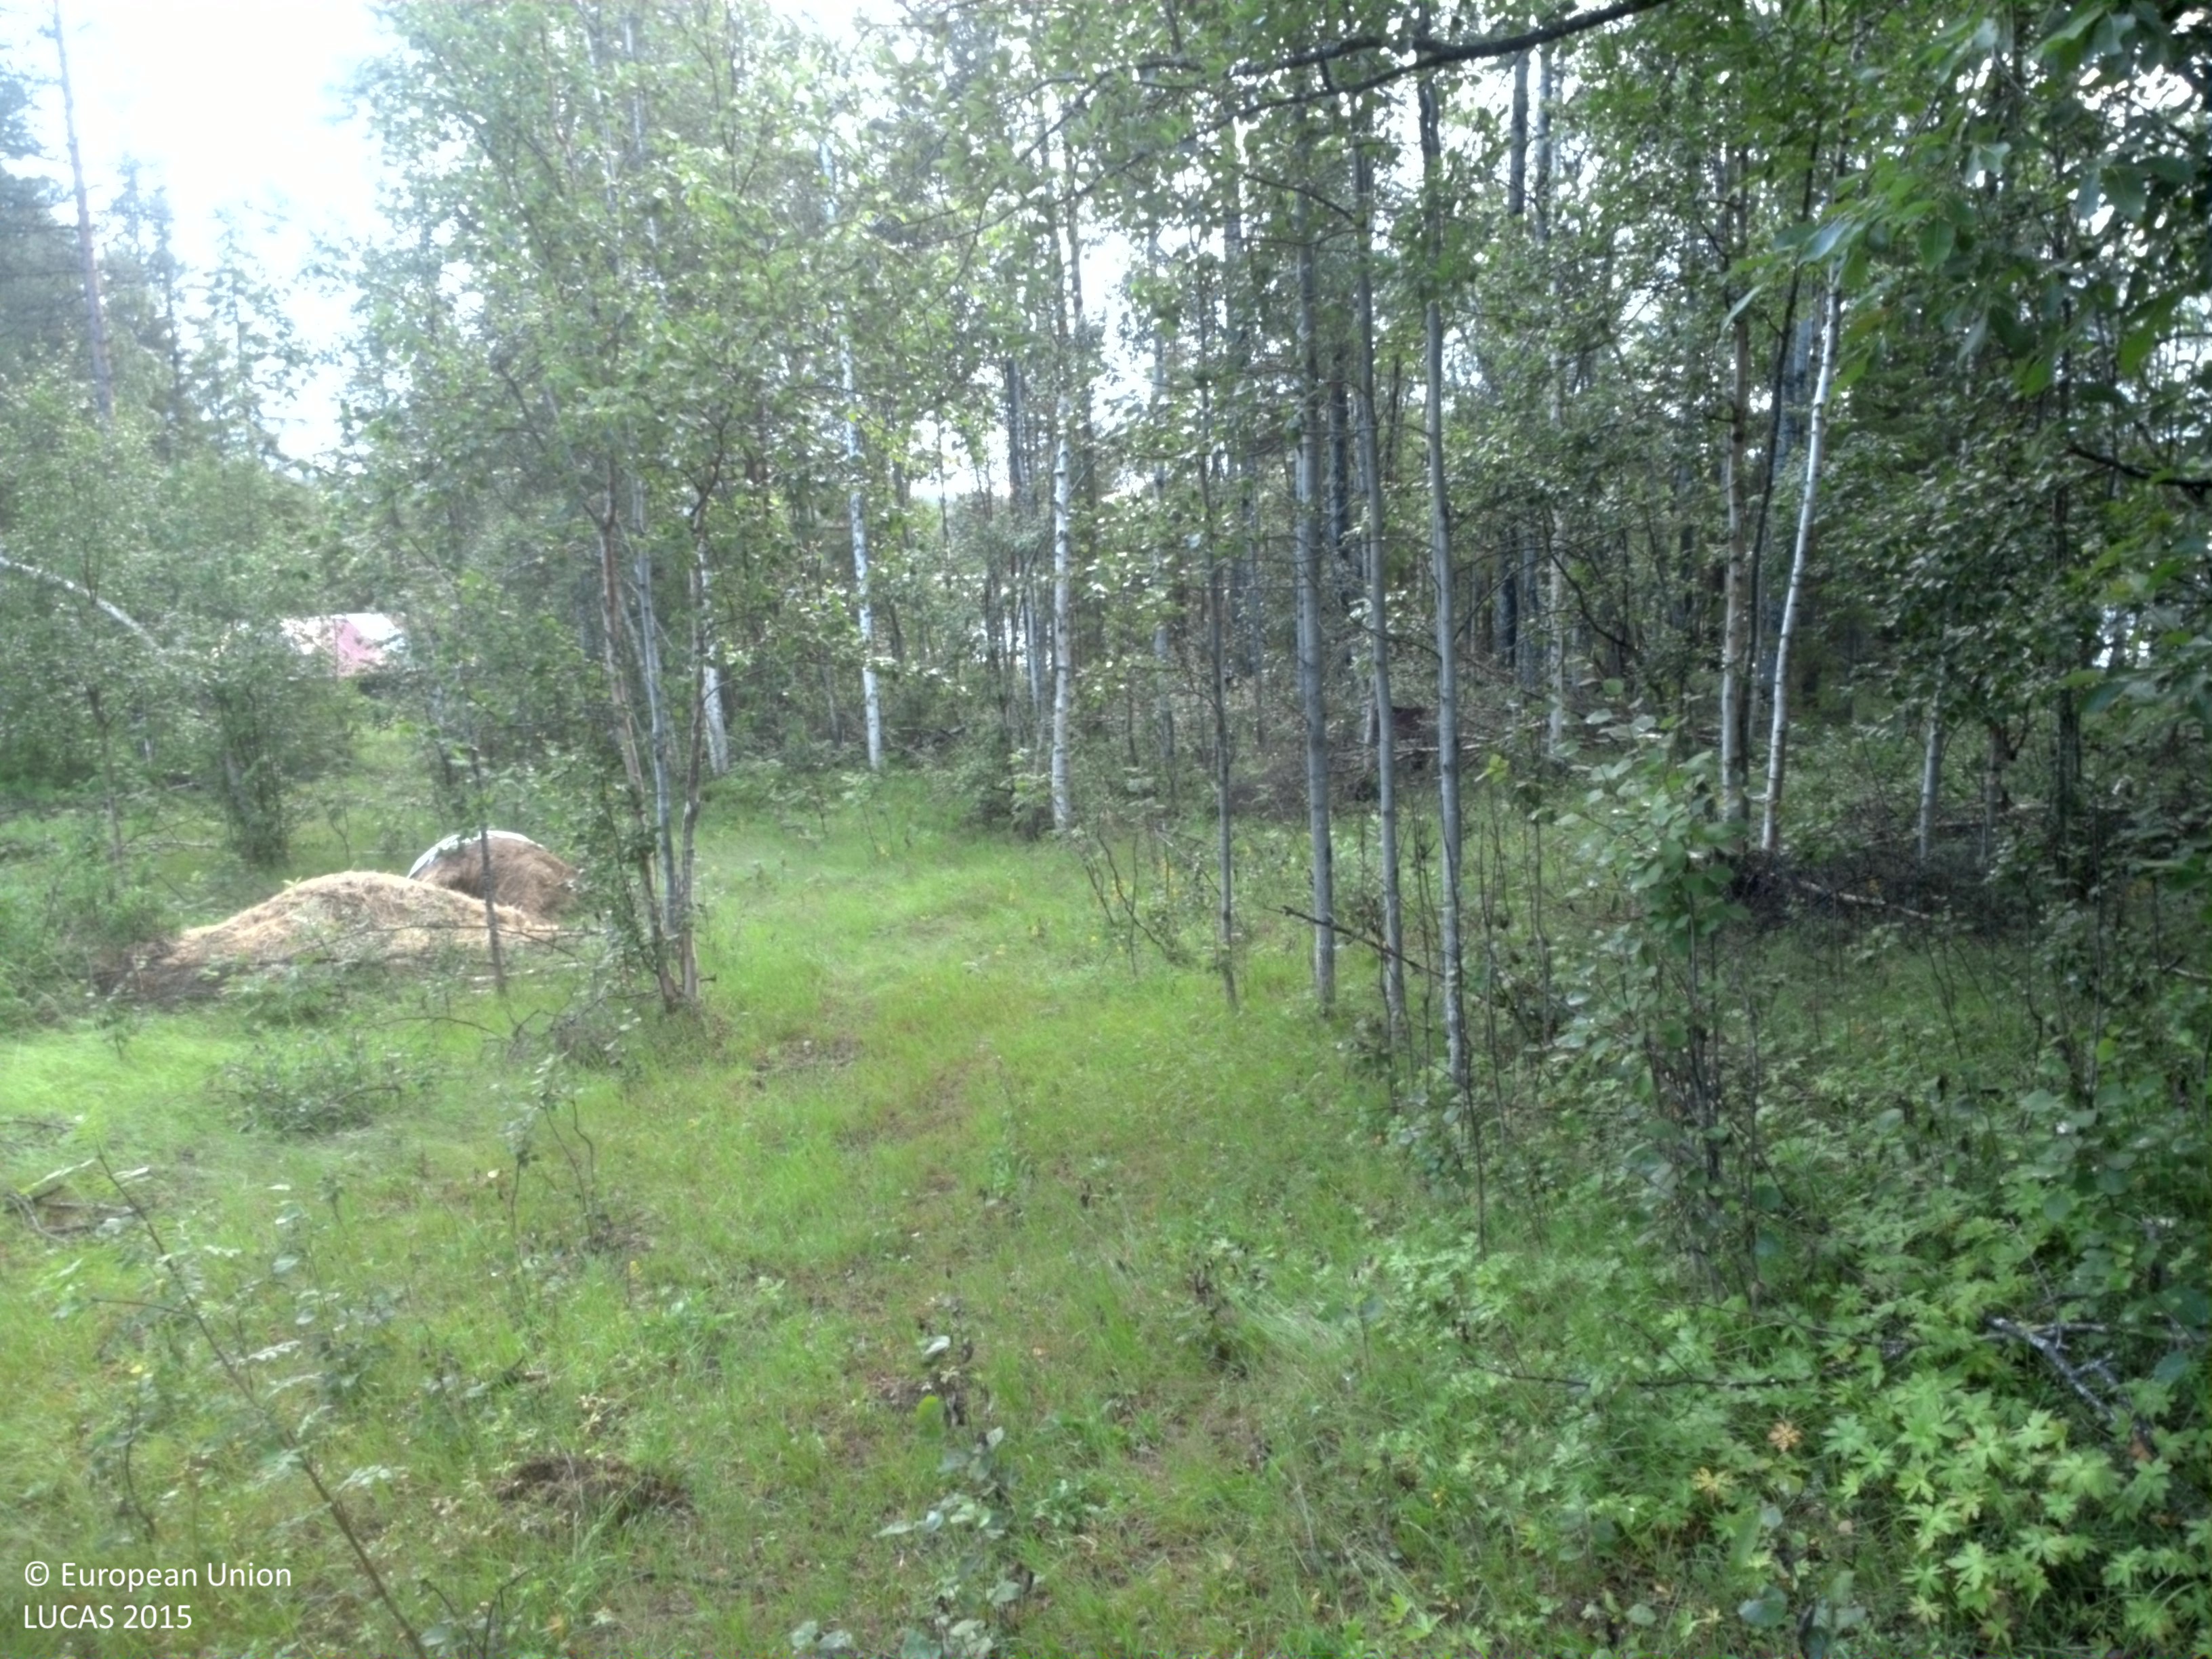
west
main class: Grassland
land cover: Grassland with sparse tree/shrub cover
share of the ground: > 75 %
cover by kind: herbaceous plants 85 %, shrubs 10 %, broadleaved forest trees 5 %
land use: Abandoned areas
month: July
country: SE
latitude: 66.1381
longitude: 20.3938
